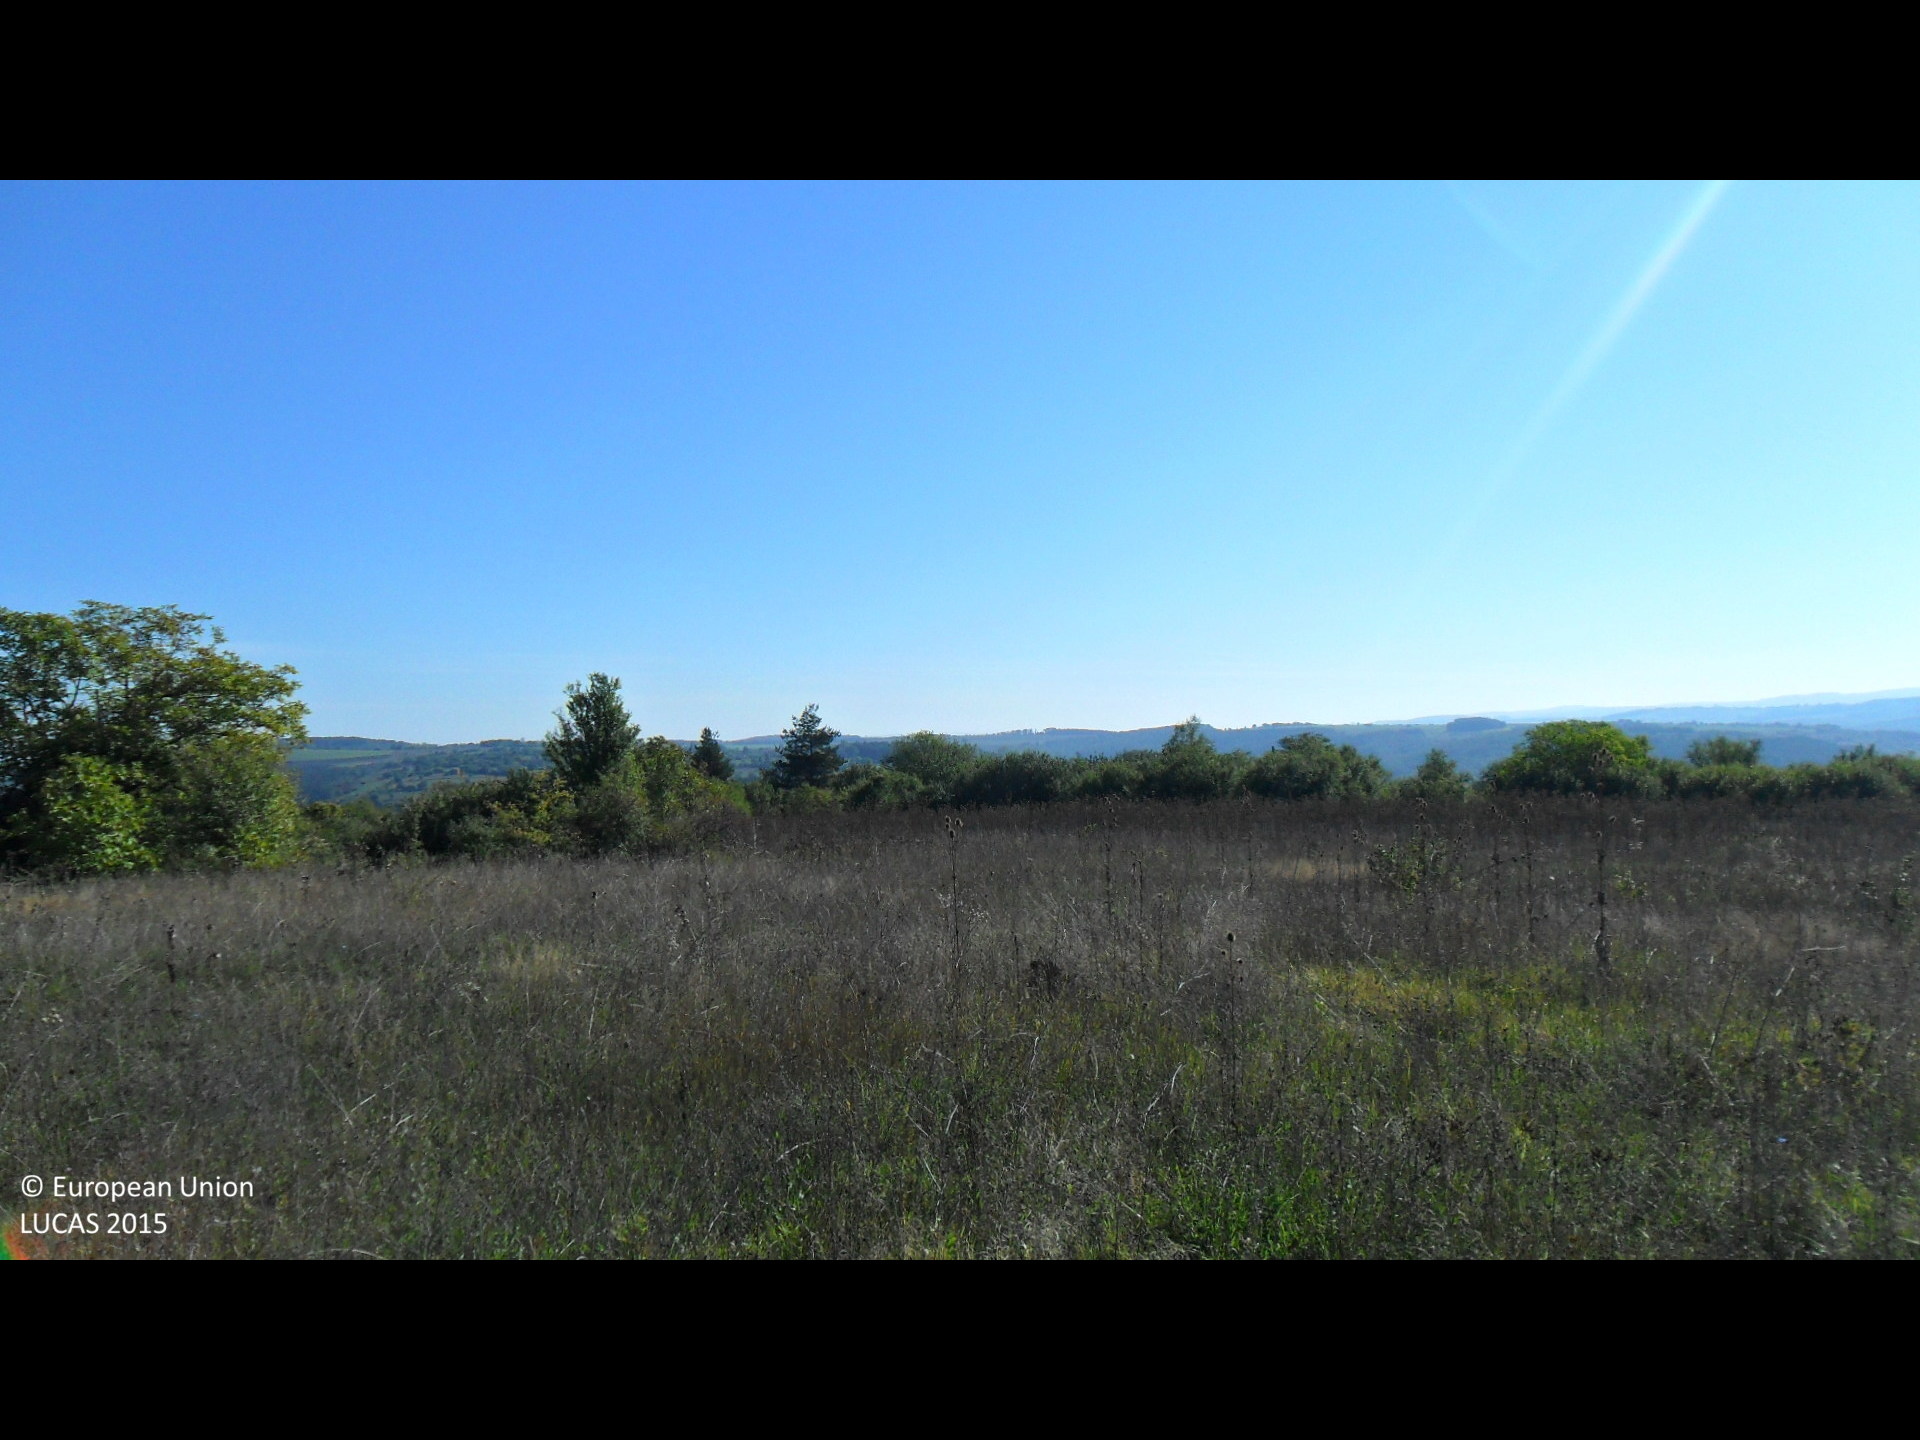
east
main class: Grassland
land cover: Grassland without tree/shrub cover
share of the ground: > 75 %
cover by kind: herbaceous plants 100 %
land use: Semi-natural and natural areas not in use
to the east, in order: Grassland without tree/shrub cover; Tracks; Shrubland with sparse tree cover; Artificial constructions in urban areas
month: October
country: BG
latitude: 43.1703
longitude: 26.2455
